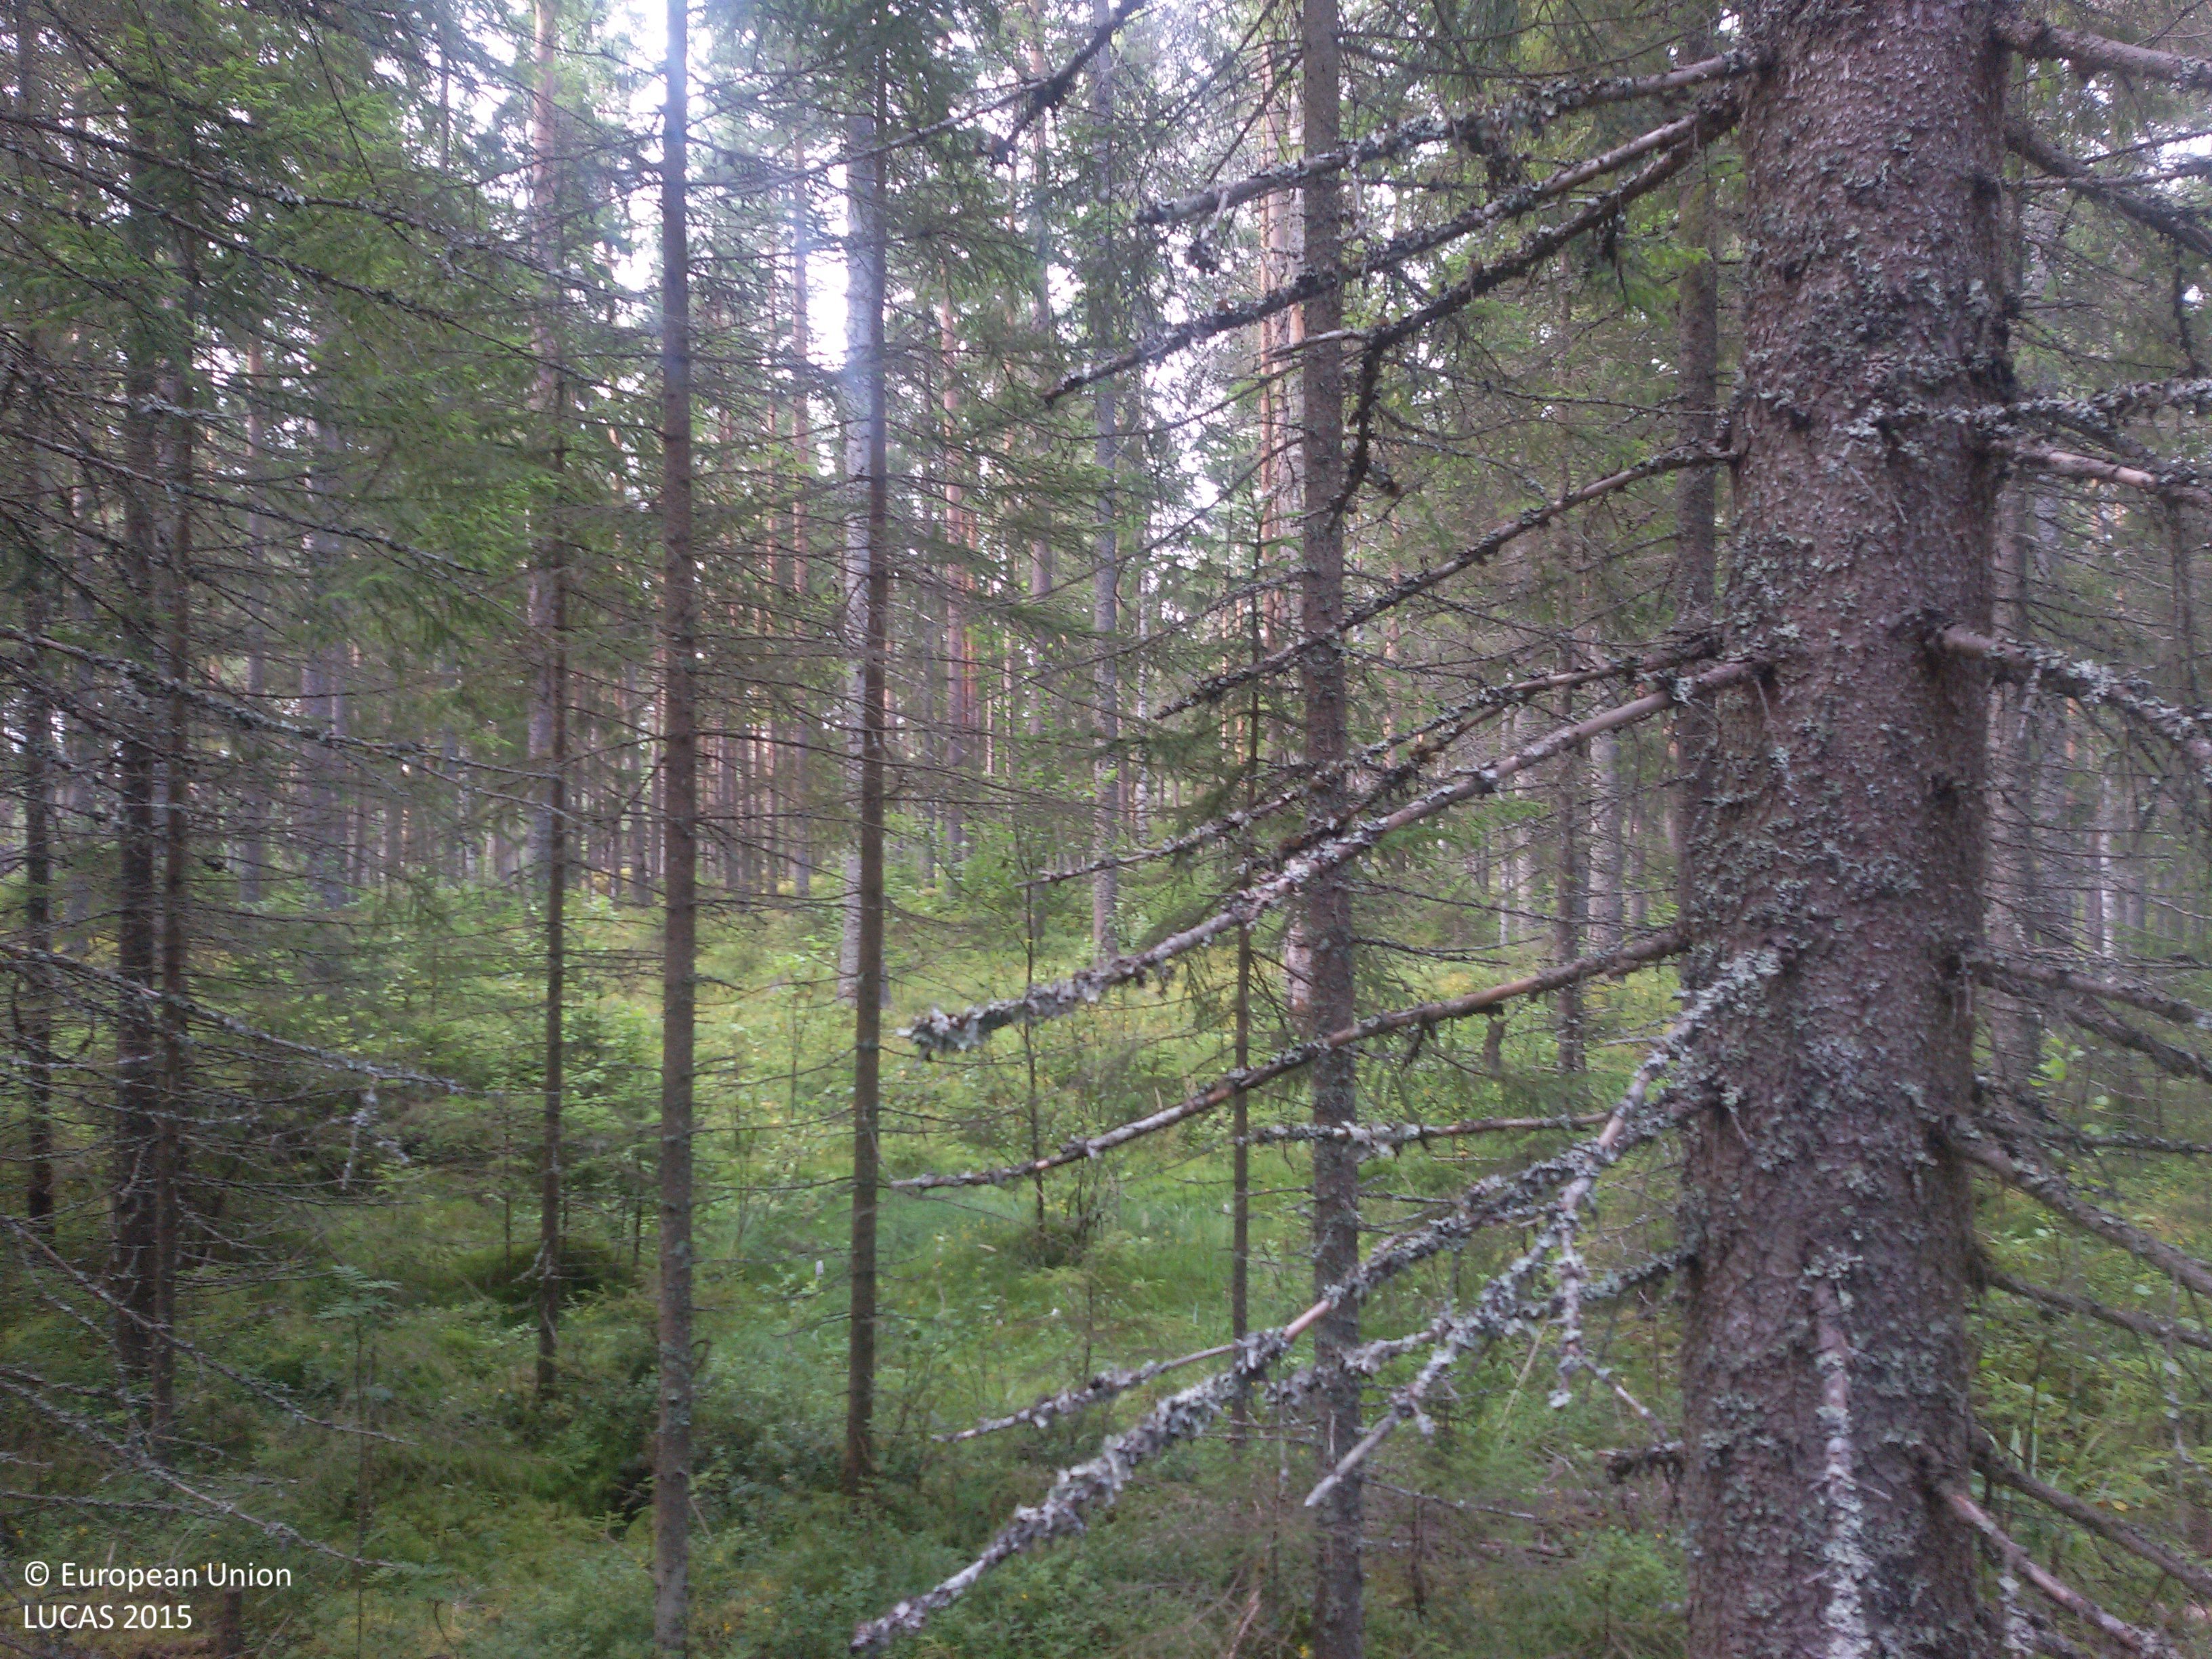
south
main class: Woodland
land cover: Spruce dominated coniferous woodland
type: boreal forest
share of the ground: > 75 %
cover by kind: coniferous forest trees 75 %, shrubs 15 %, herbaceous plants 5 %, lichens and mosses 5 %
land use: Forestry
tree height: > 5 m
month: August
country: SE
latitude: 60.6299
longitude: 16.4403
